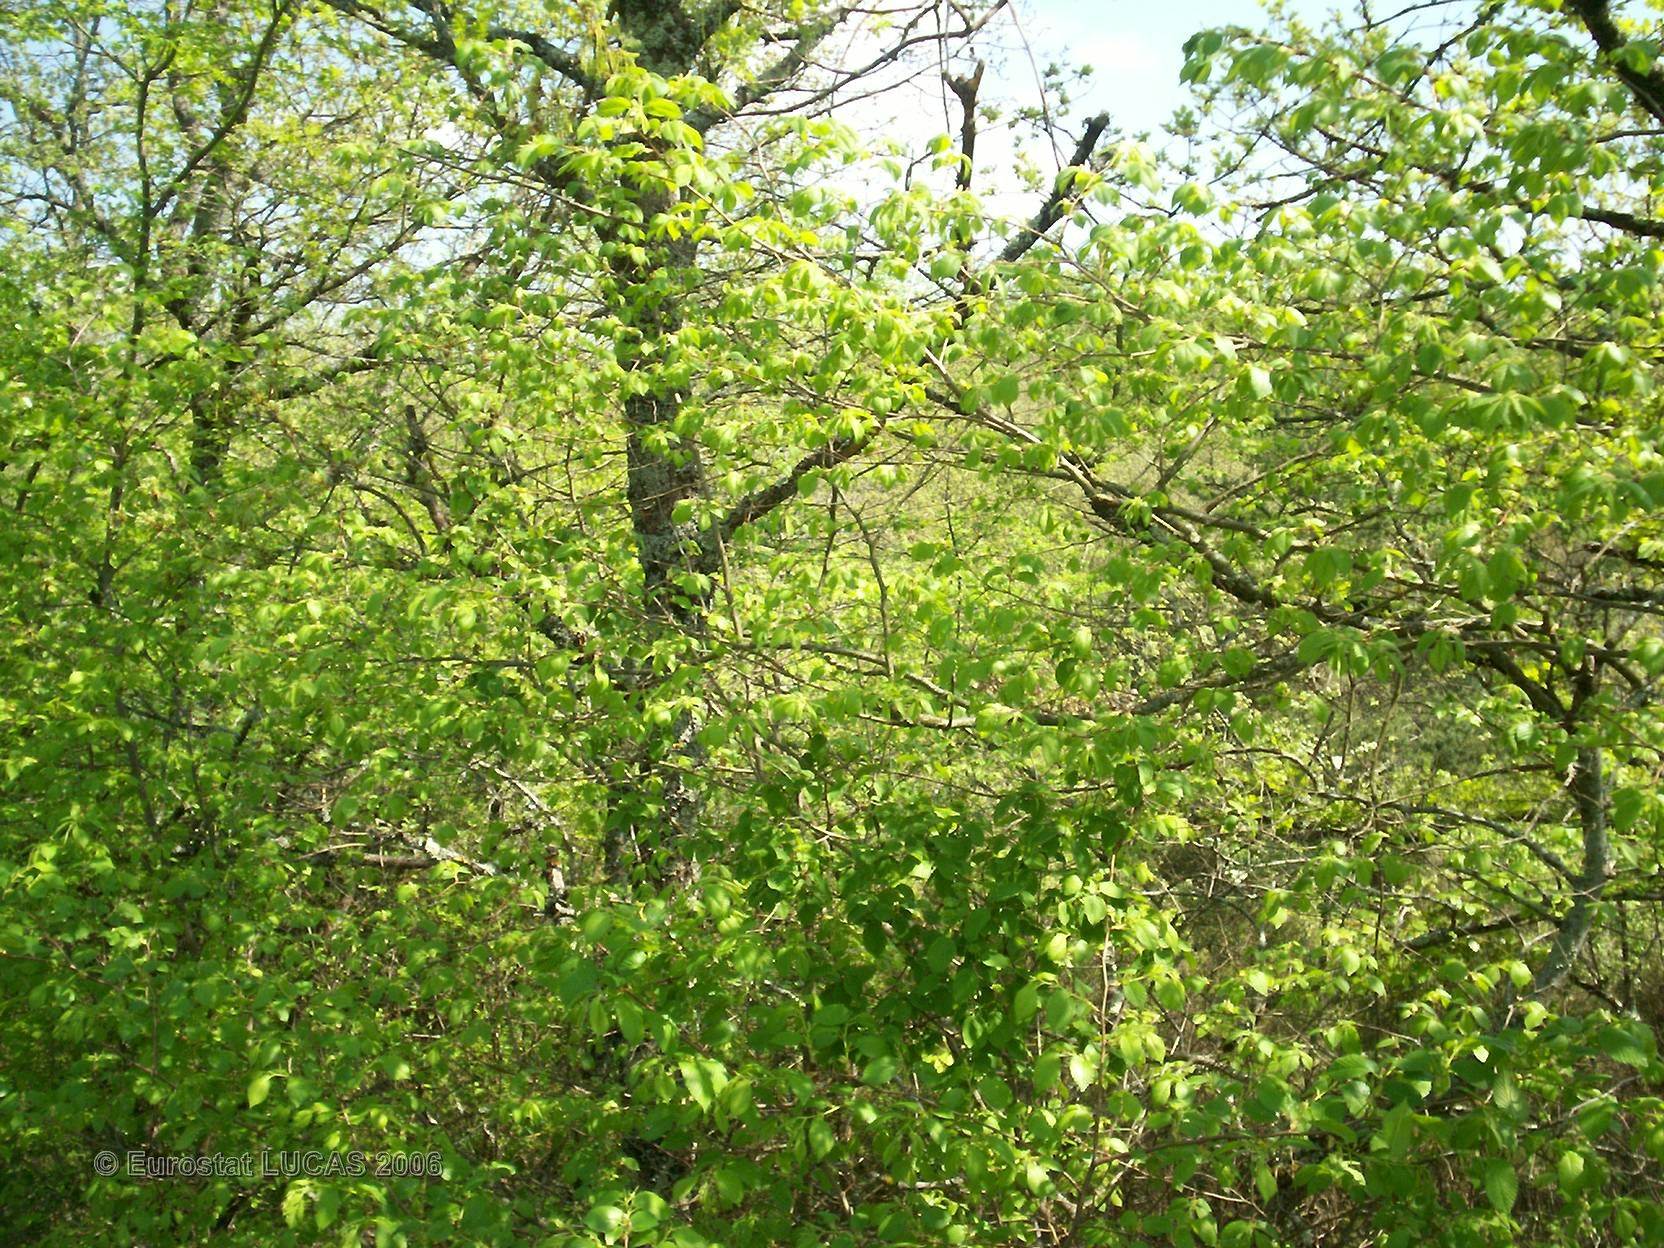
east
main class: Woodland
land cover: Broadleaved forest
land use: Forestry
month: April
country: FR
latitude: 43.6812
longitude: 2.0284
